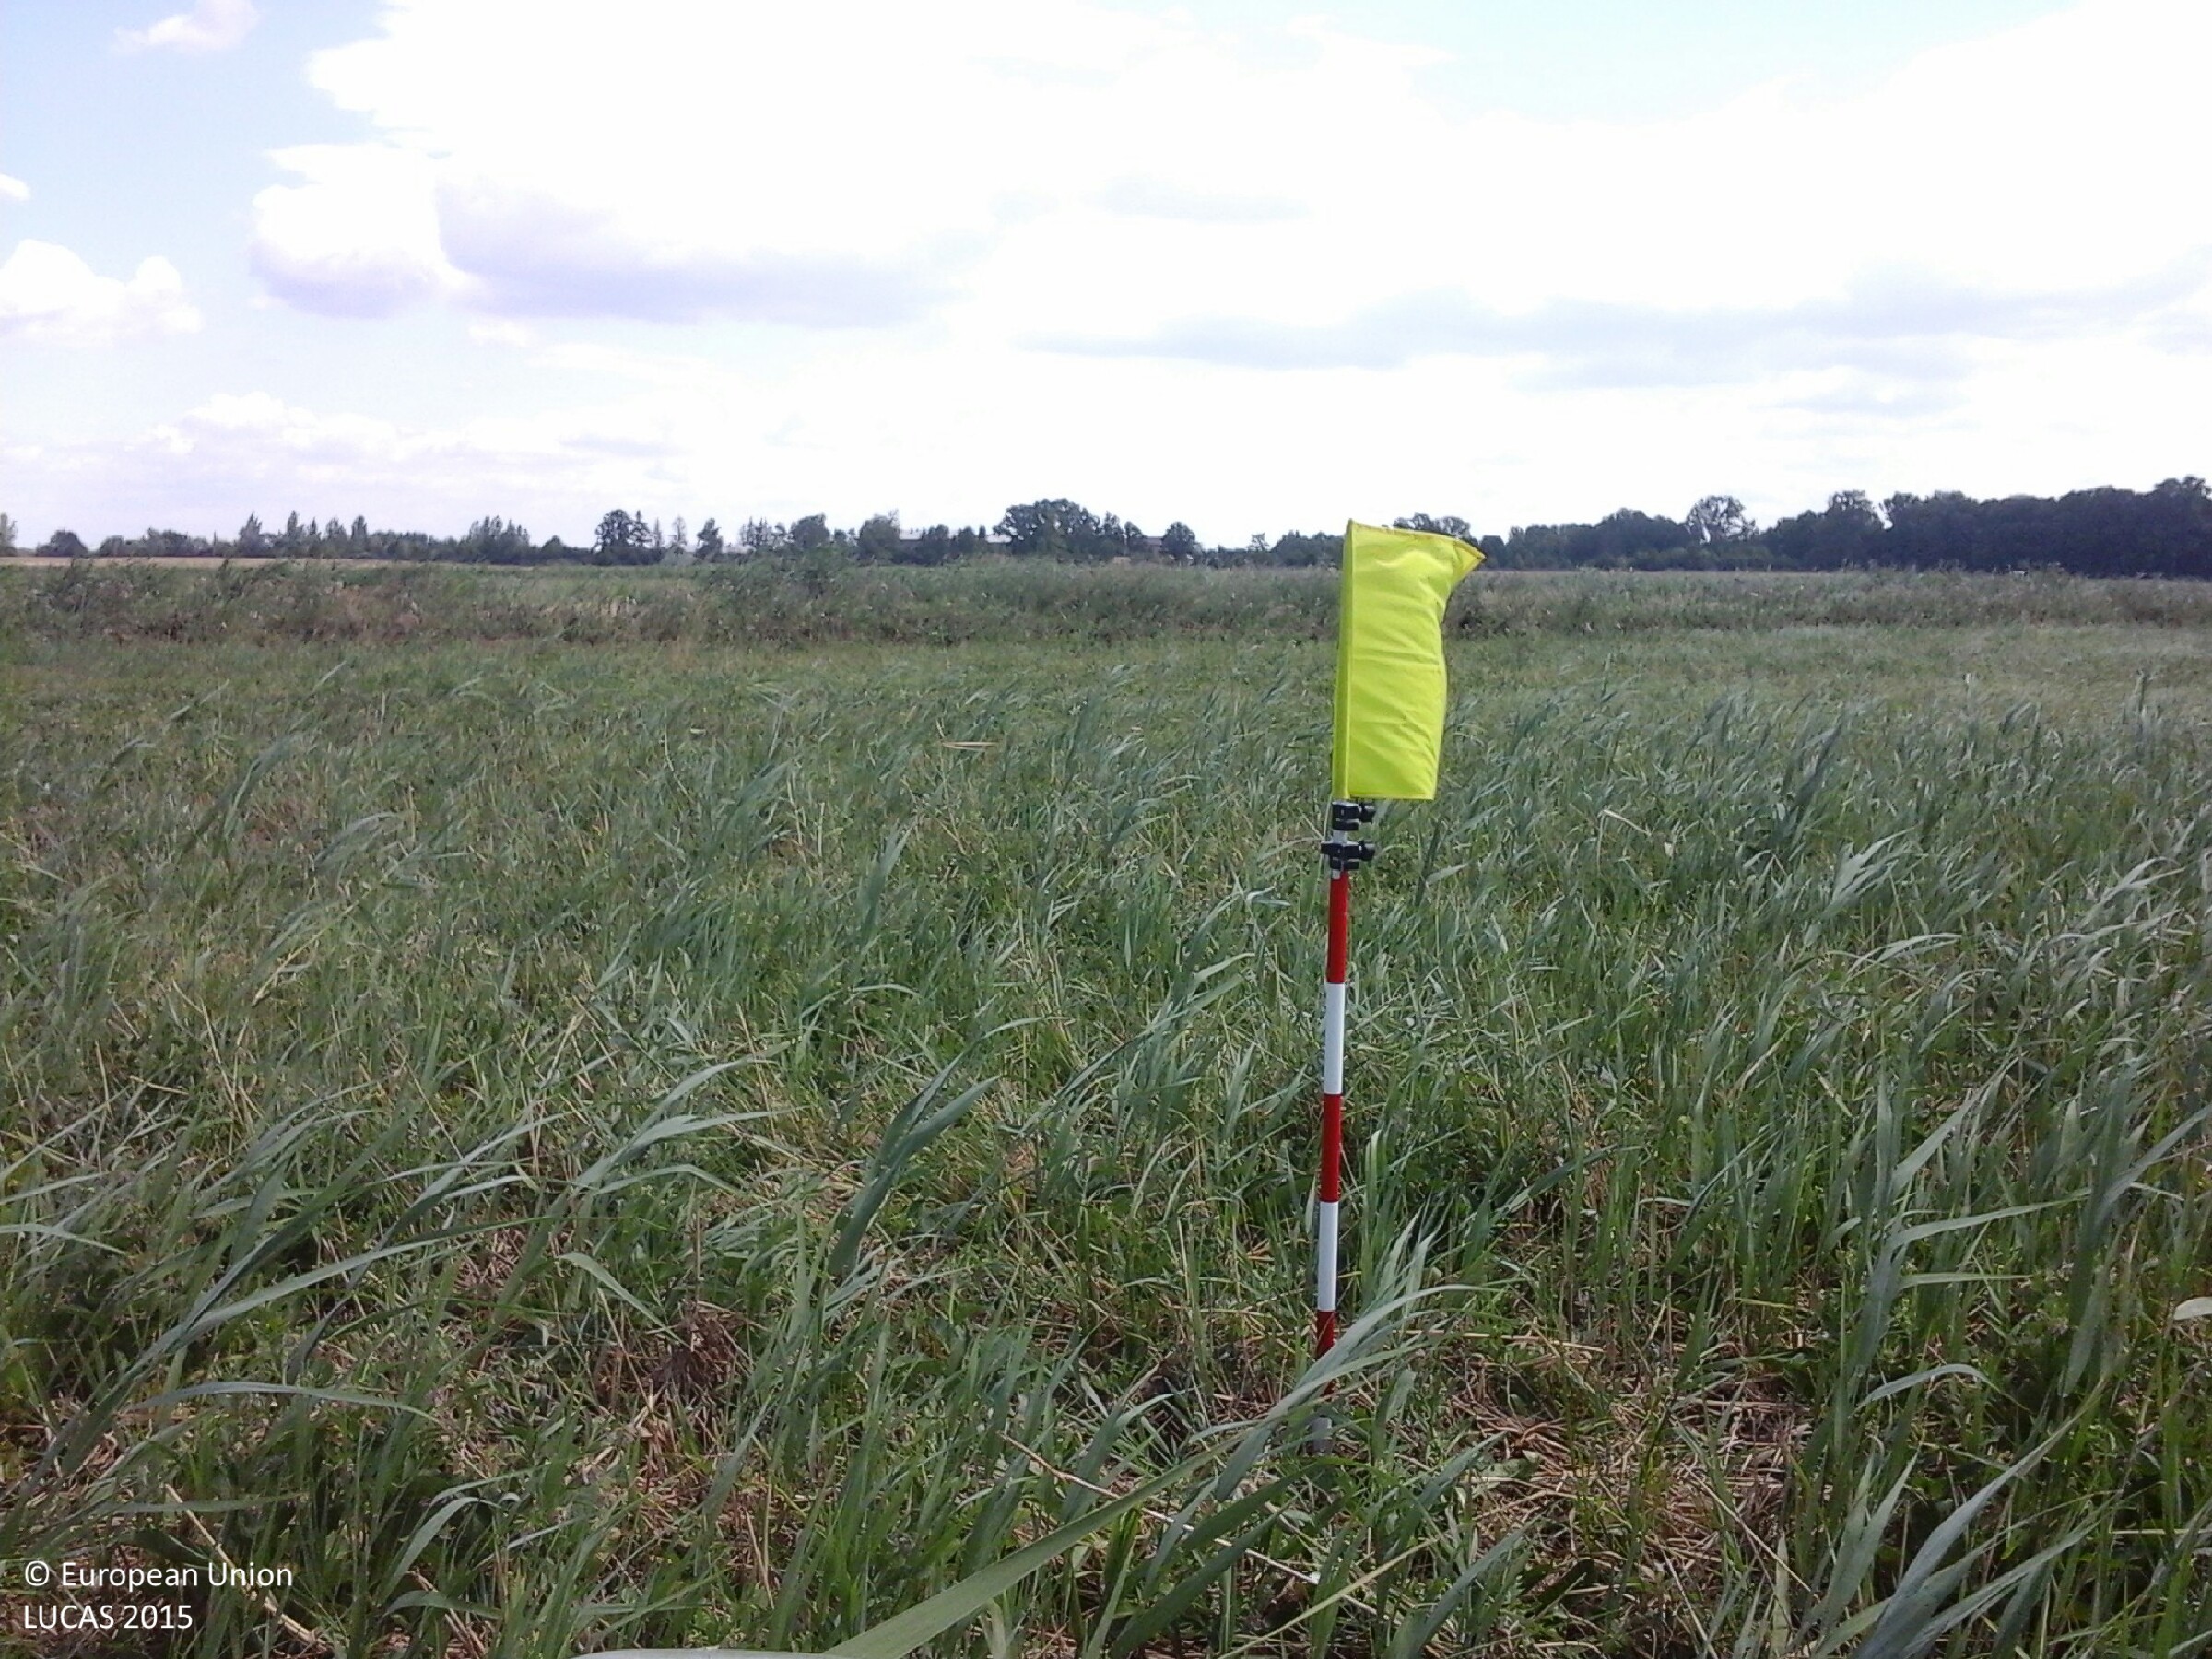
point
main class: Cropland
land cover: Permanent industrial crops
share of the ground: > 75 %
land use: Agriculture (excluding fallow land and kitchen gardens)
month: July
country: HU
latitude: 47.7819
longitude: 20.6174
